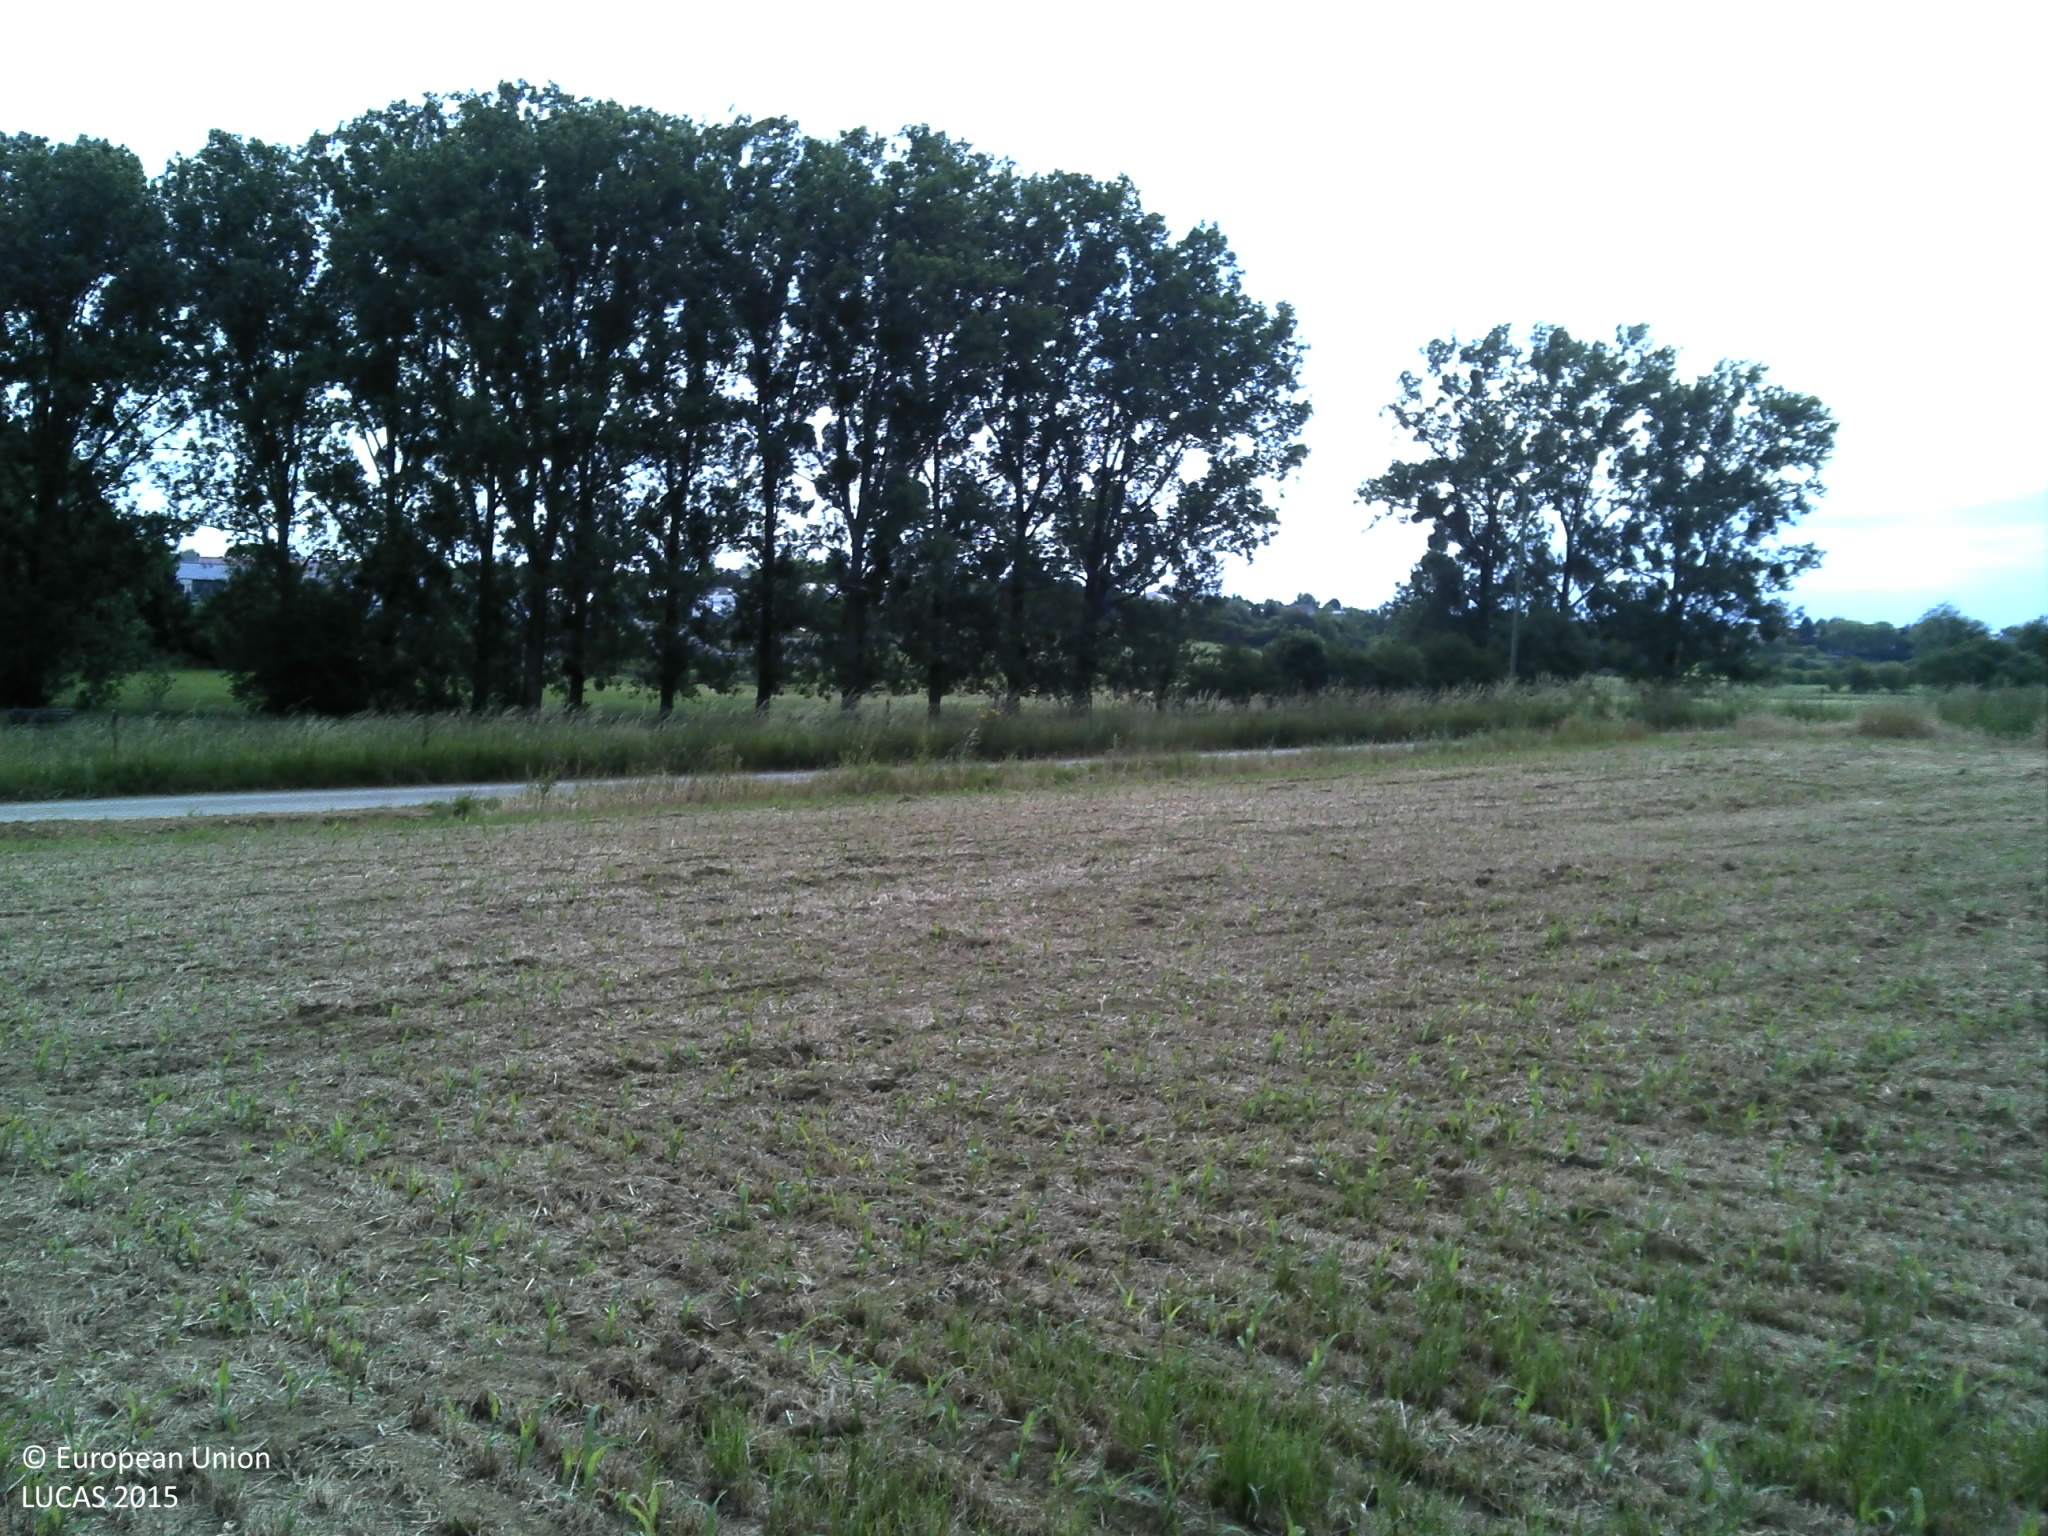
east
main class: Cropland
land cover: Maize
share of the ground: < 10 %
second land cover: Temporary grasslands
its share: 25 - 50 %
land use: Agriculture (excluding fallow land and kitchen gardens)
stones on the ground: < 10 %
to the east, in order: Maize; Temporary grasslands; Grass margins; Paved roads, cycling and walking lanes; Grass margins; Fences; Grassland without tree/shrub cover; Fences; Broadleaved woodland; Rivers and streams; Broadleaved woodland; Grassland without tree/shrub cover; Fences; Grassland without tree/shrub cover; Fences; Grassland without tree/shrub cover
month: June
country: LU
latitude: 49.5211
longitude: 6.0347
